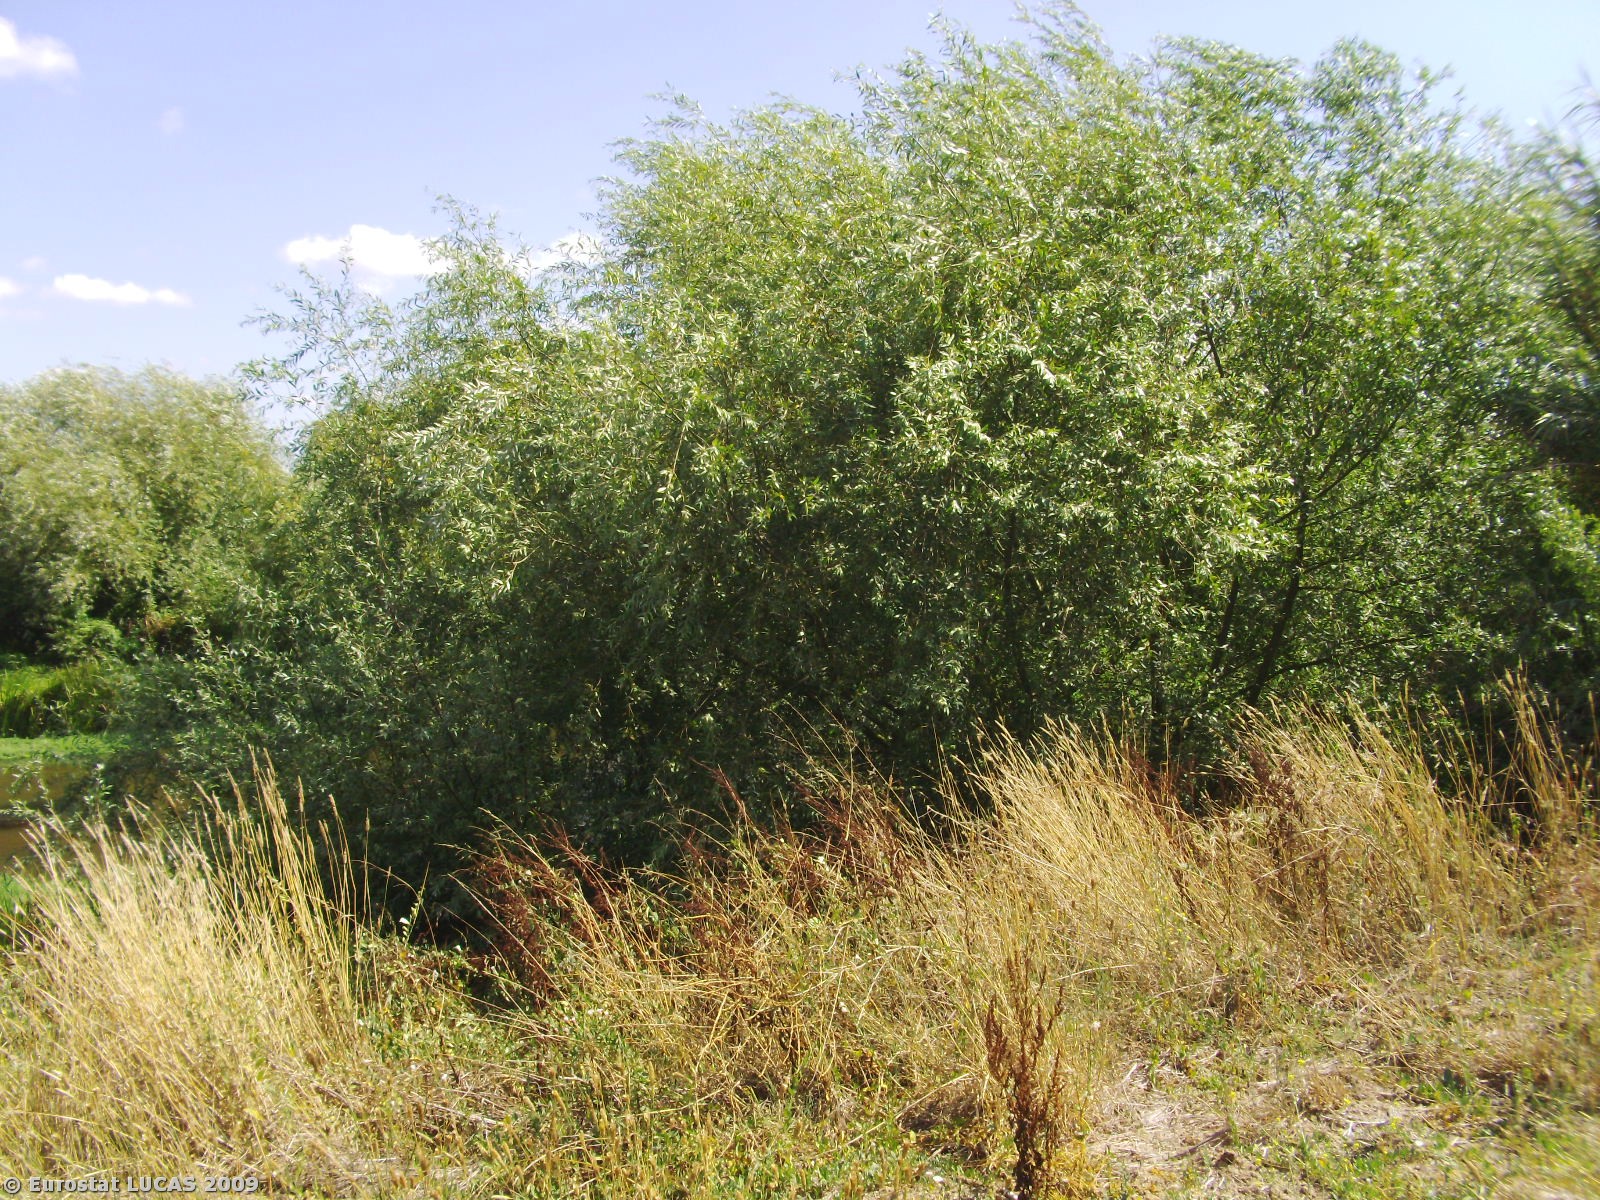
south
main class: Grassland
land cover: Spontaneously vegetated surfaces
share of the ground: 10 - 25 %
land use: Unused
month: July
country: PT
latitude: 38.9767
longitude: -8.7575
